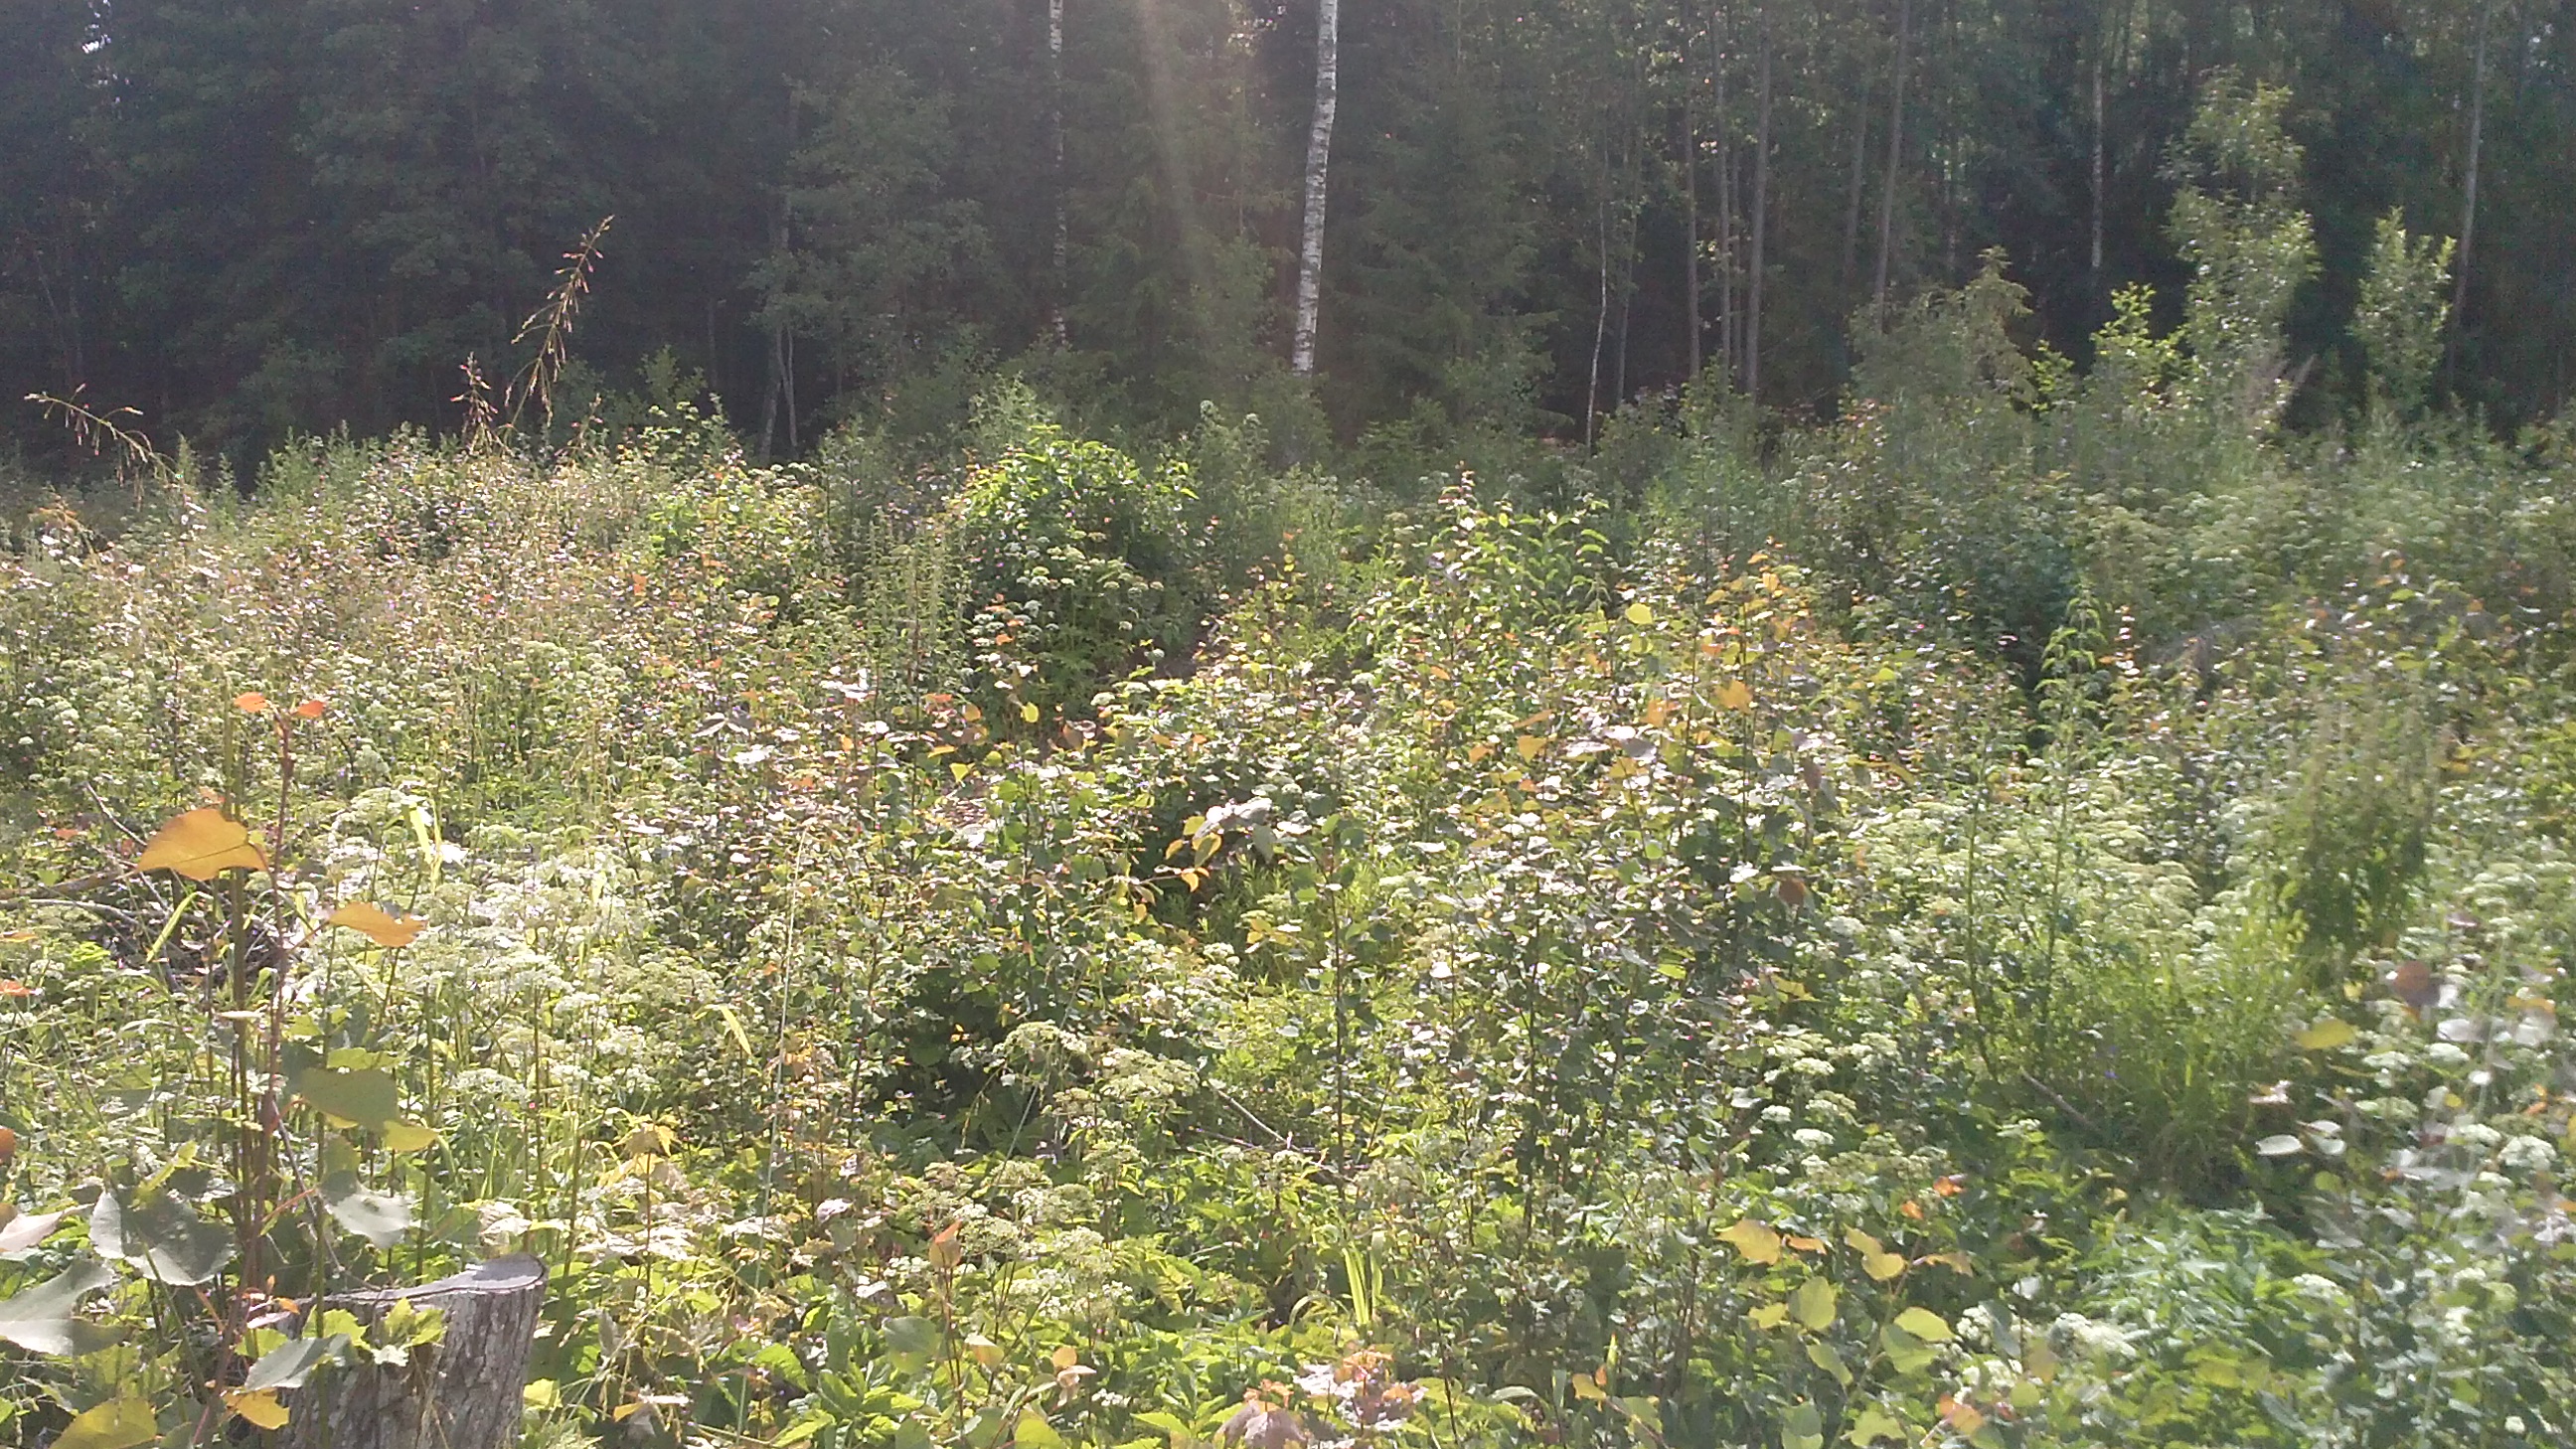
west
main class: Woodland
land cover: Broadleaved woodland
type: non-riverine alder, birch or aspen forest
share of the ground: > 75 %
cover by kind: broadleaved forest trees 100 %
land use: Forestry
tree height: < 5 m
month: June
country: LV
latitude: 56.6602
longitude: 27.9605
